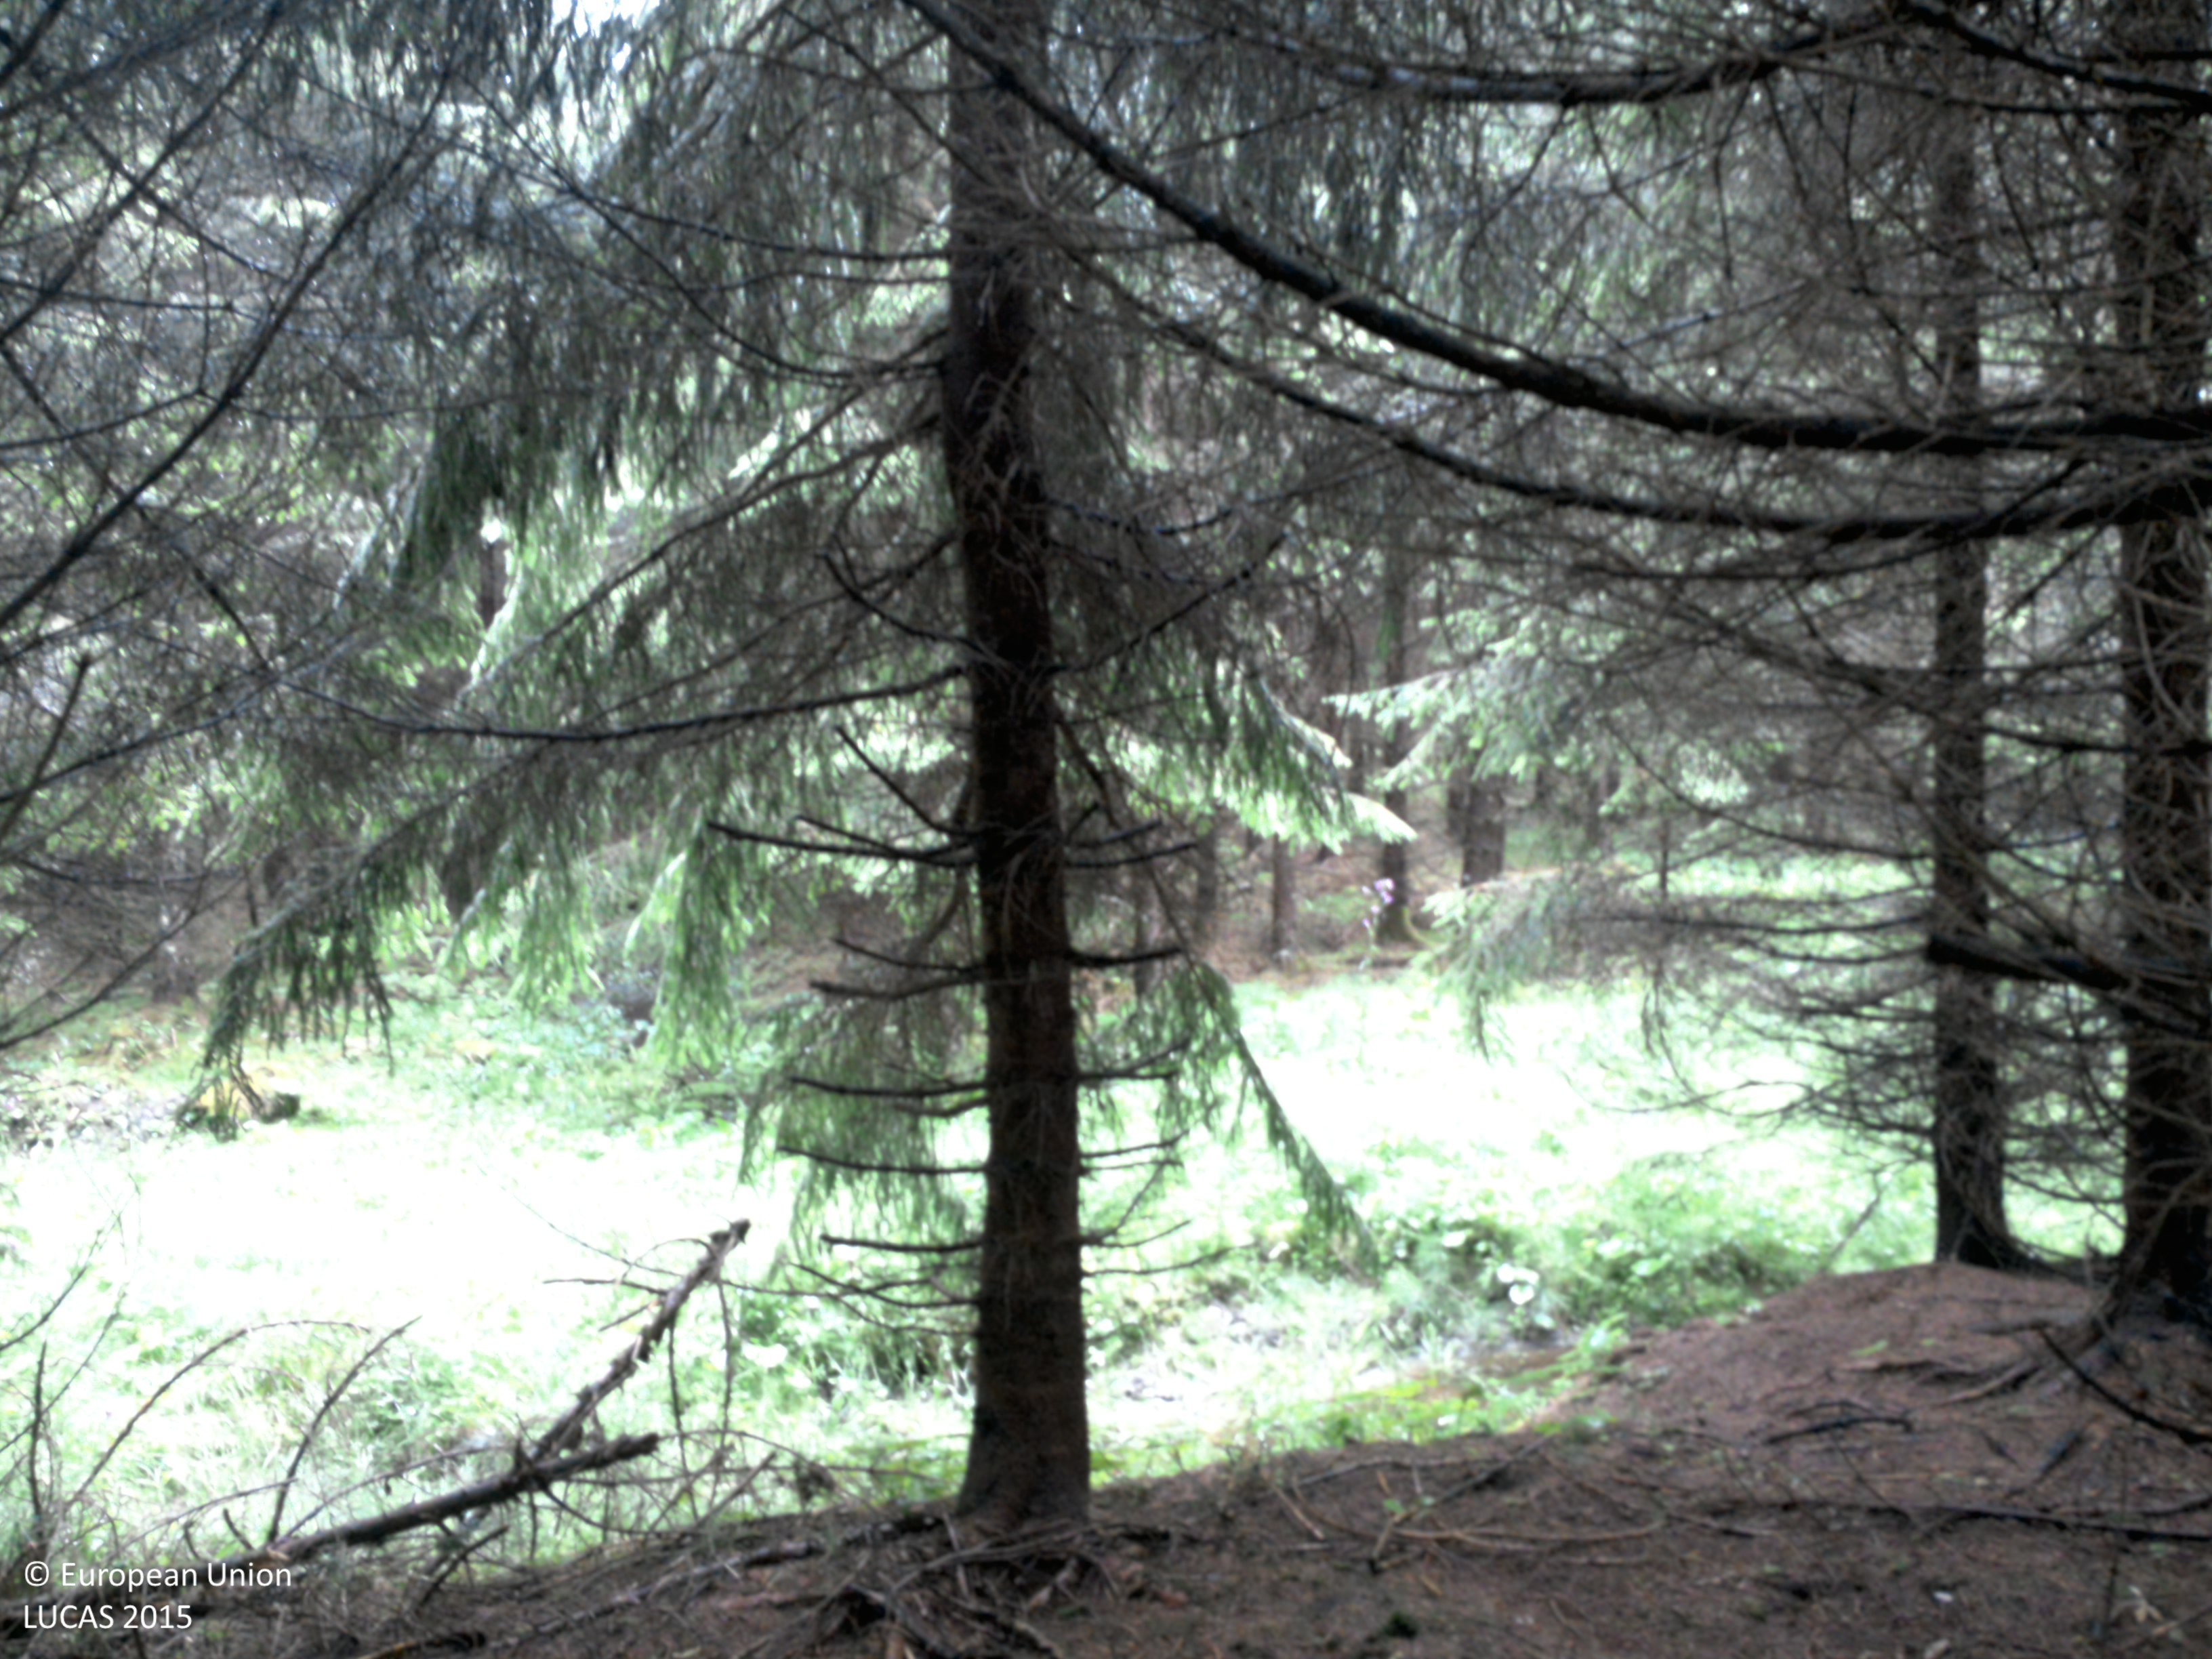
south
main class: Woodland
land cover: Spruce dominated coniferous woodland
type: boreal forest
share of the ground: > 75 %
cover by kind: coniferous forest trees 80 %, lichens and mosses 20 %
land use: Forestry
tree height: > 5 m
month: July
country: SE
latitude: 58.6902
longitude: 12.0142
